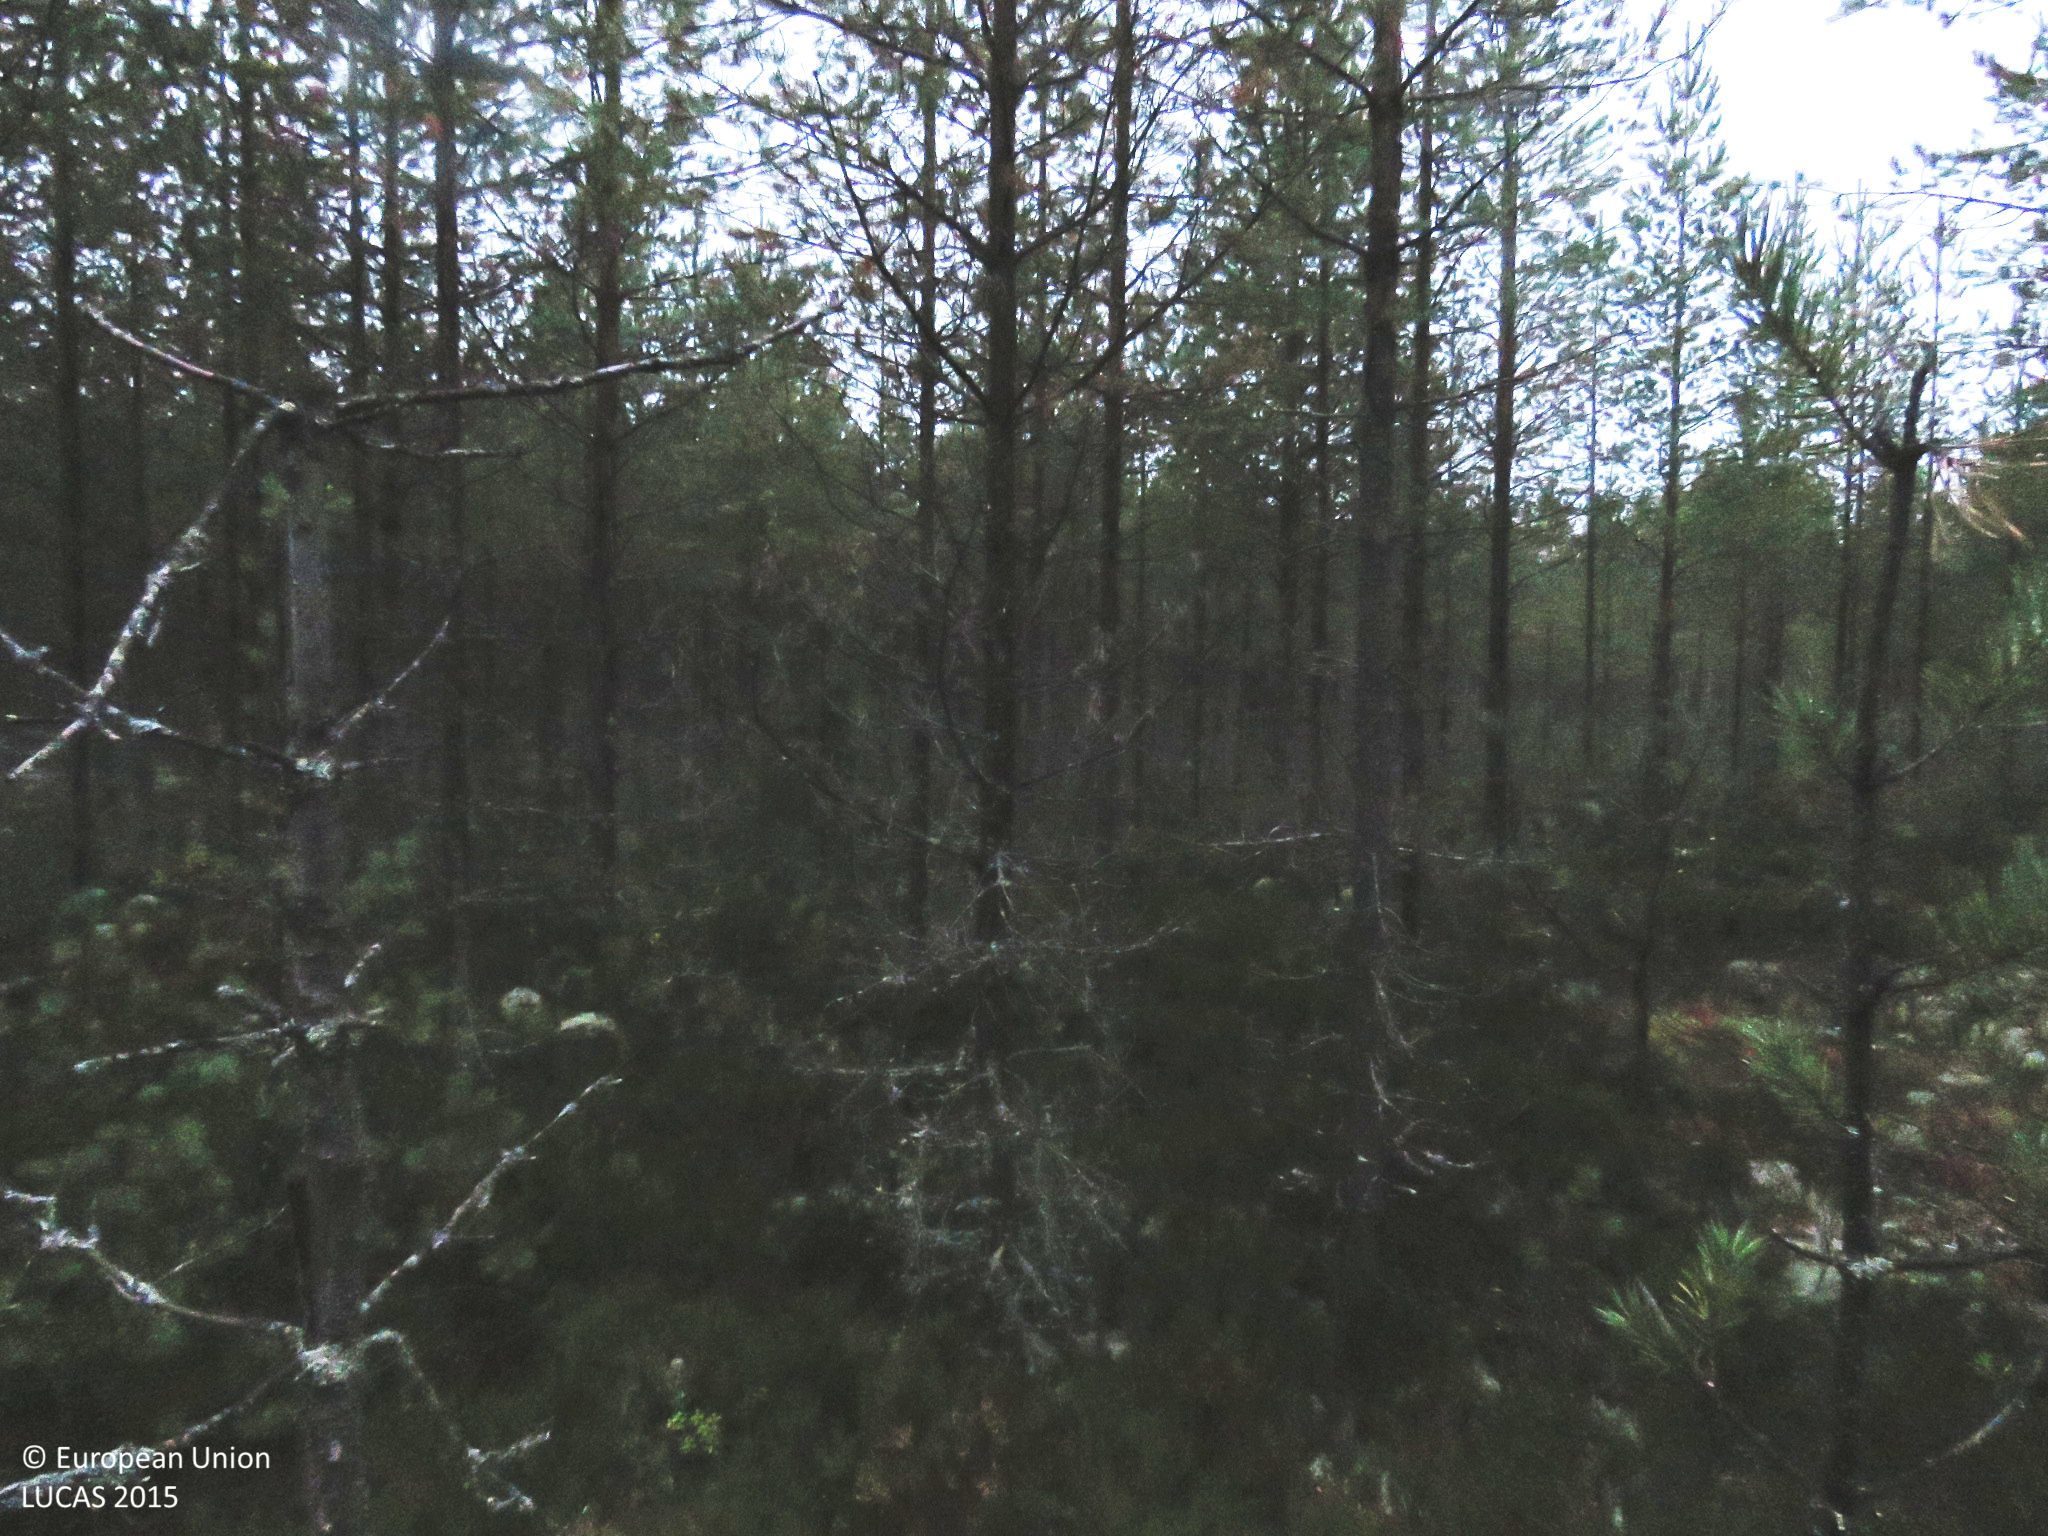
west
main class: Woodland
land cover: Pine dominated coniferous woodland
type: boreal forest
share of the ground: > 75 %
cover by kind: coniferous forest trees 65 %, shrubs 20 %, broadleaved forest trees 10 %, lichens and mosses 5 %
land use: Forestry
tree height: > 5 m
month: September
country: FI
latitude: 64.7955
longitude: 26.5922
